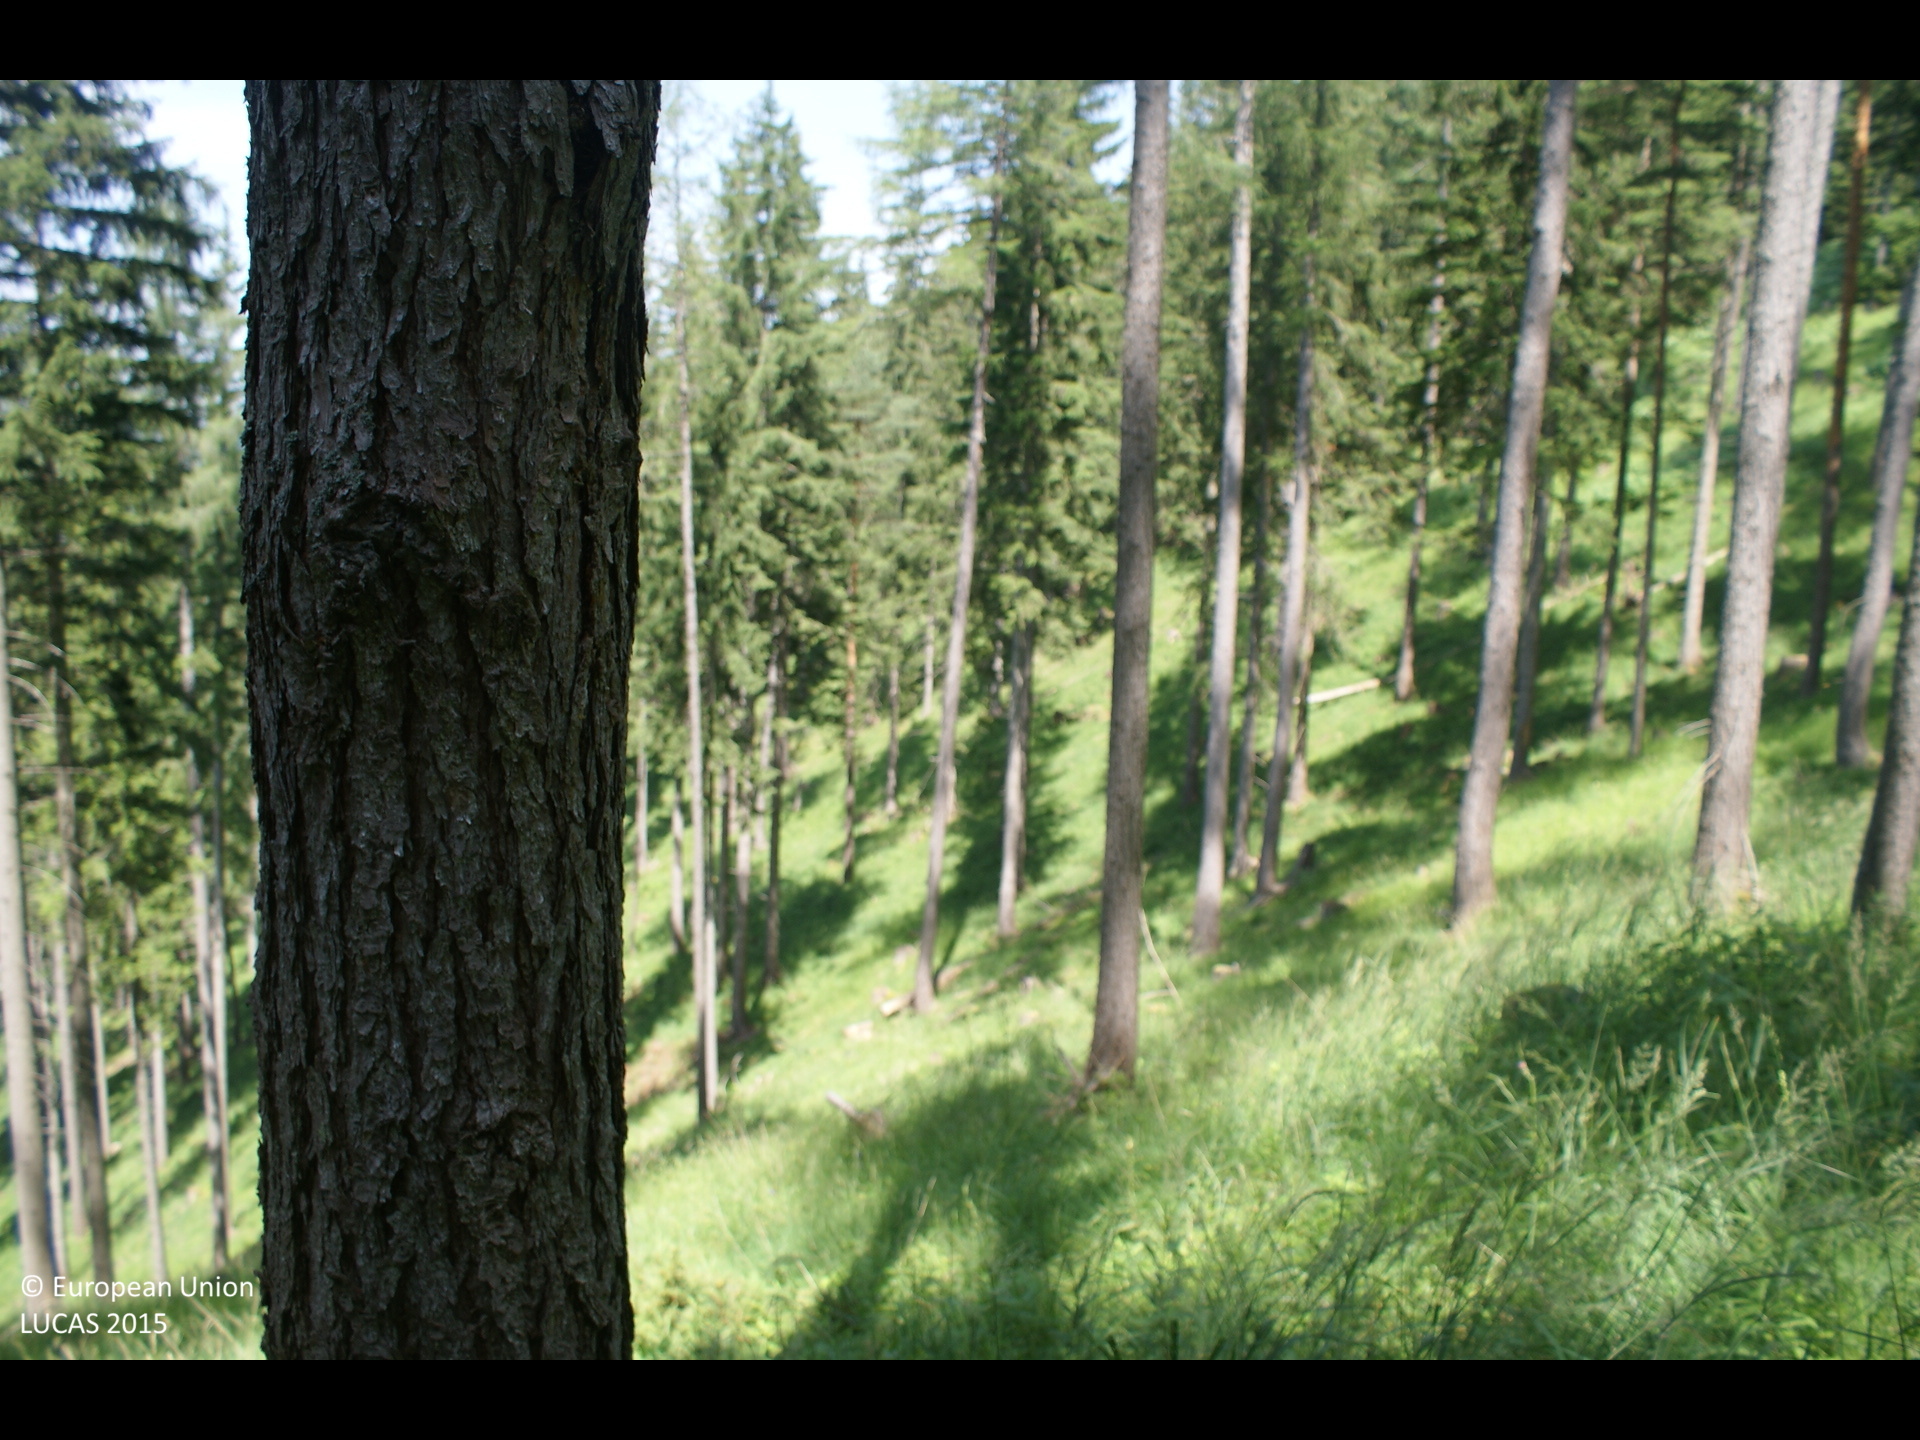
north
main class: Woodland
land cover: Other coniferous woodland
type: alpine coniferous forest
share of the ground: > 75 %
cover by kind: coniferous forest trees 75 %, herbaceous plants 20 %, shrubs 5 %
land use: Forestry
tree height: > 5 m
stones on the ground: < 10 %
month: July
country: AT
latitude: 47.8433
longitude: 15.3060
